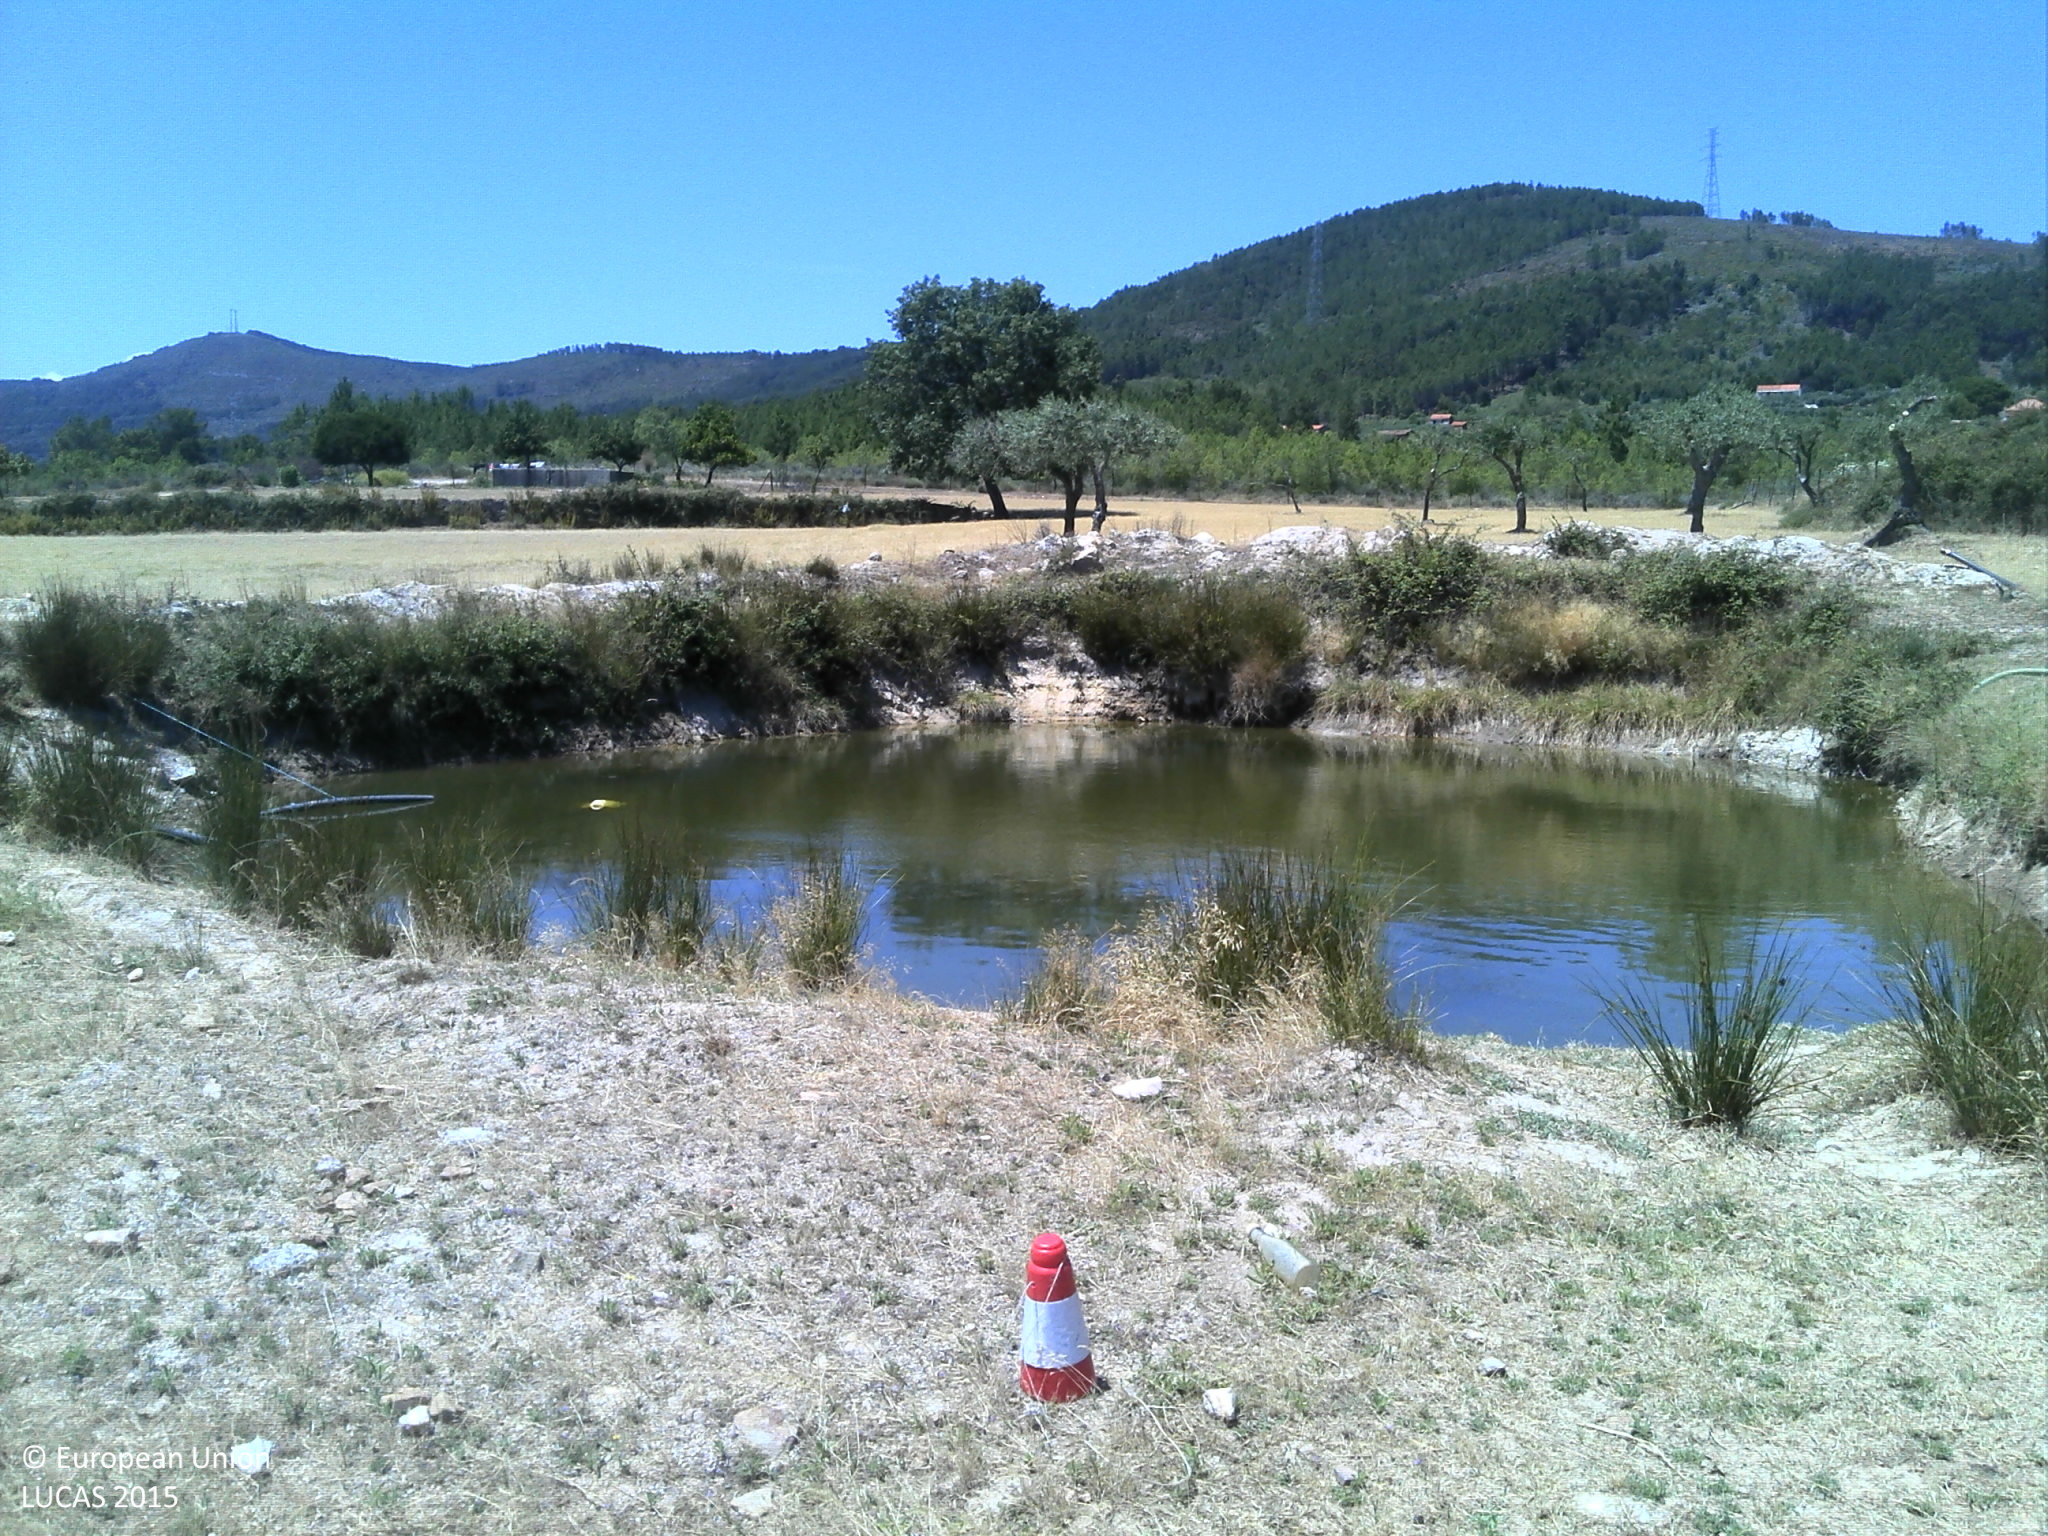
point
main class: Grassland
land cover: Grassland without tree/shrub cover
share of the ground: 25 - 50 %
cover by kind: unconsolidated bare surface 50 %, herbaceous plants 40 %
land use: Agriculture (excluding fallow land and kitchen gardens)
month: June
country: PT
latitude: 40.1049
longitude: -7.3814
